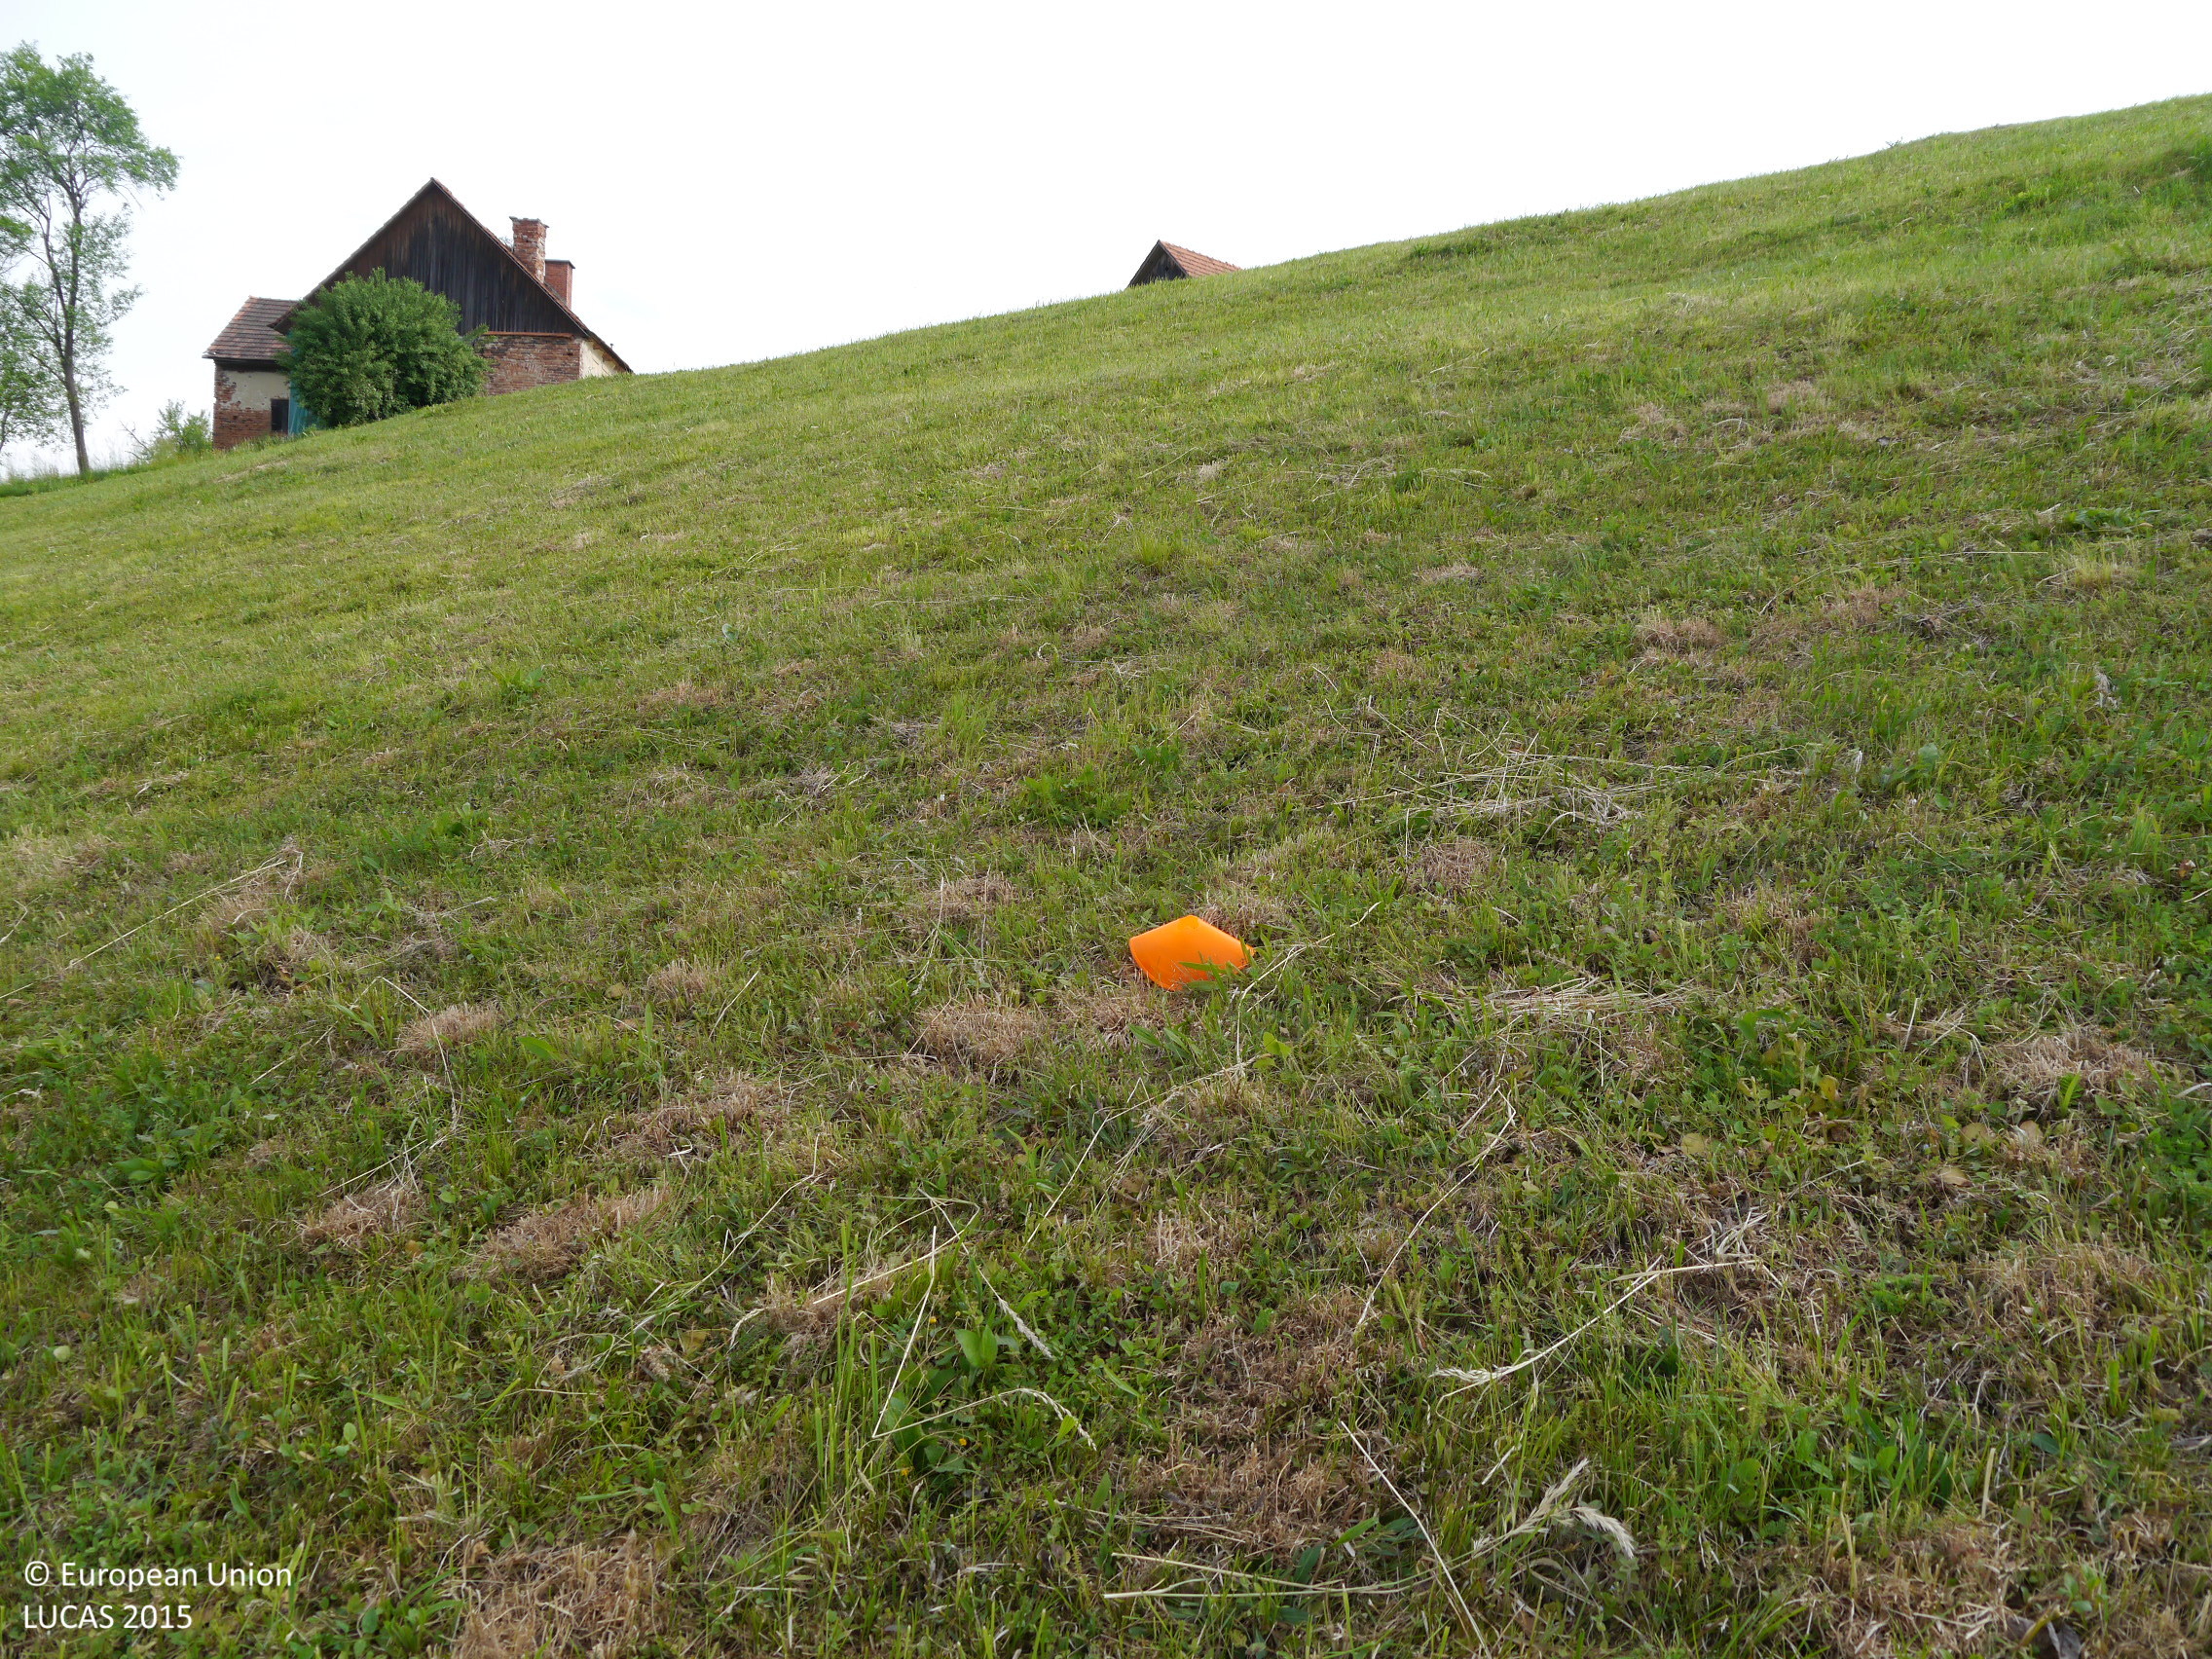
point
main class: Grassland
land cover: Grassland without tree/shrub cover
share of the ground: > 75 %
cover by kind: herbaceous plants 100 %
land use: Agriculture (excluding fallow land and kitchen gardens)
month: May
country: AT
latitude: 46.9772
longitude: 15.6659
